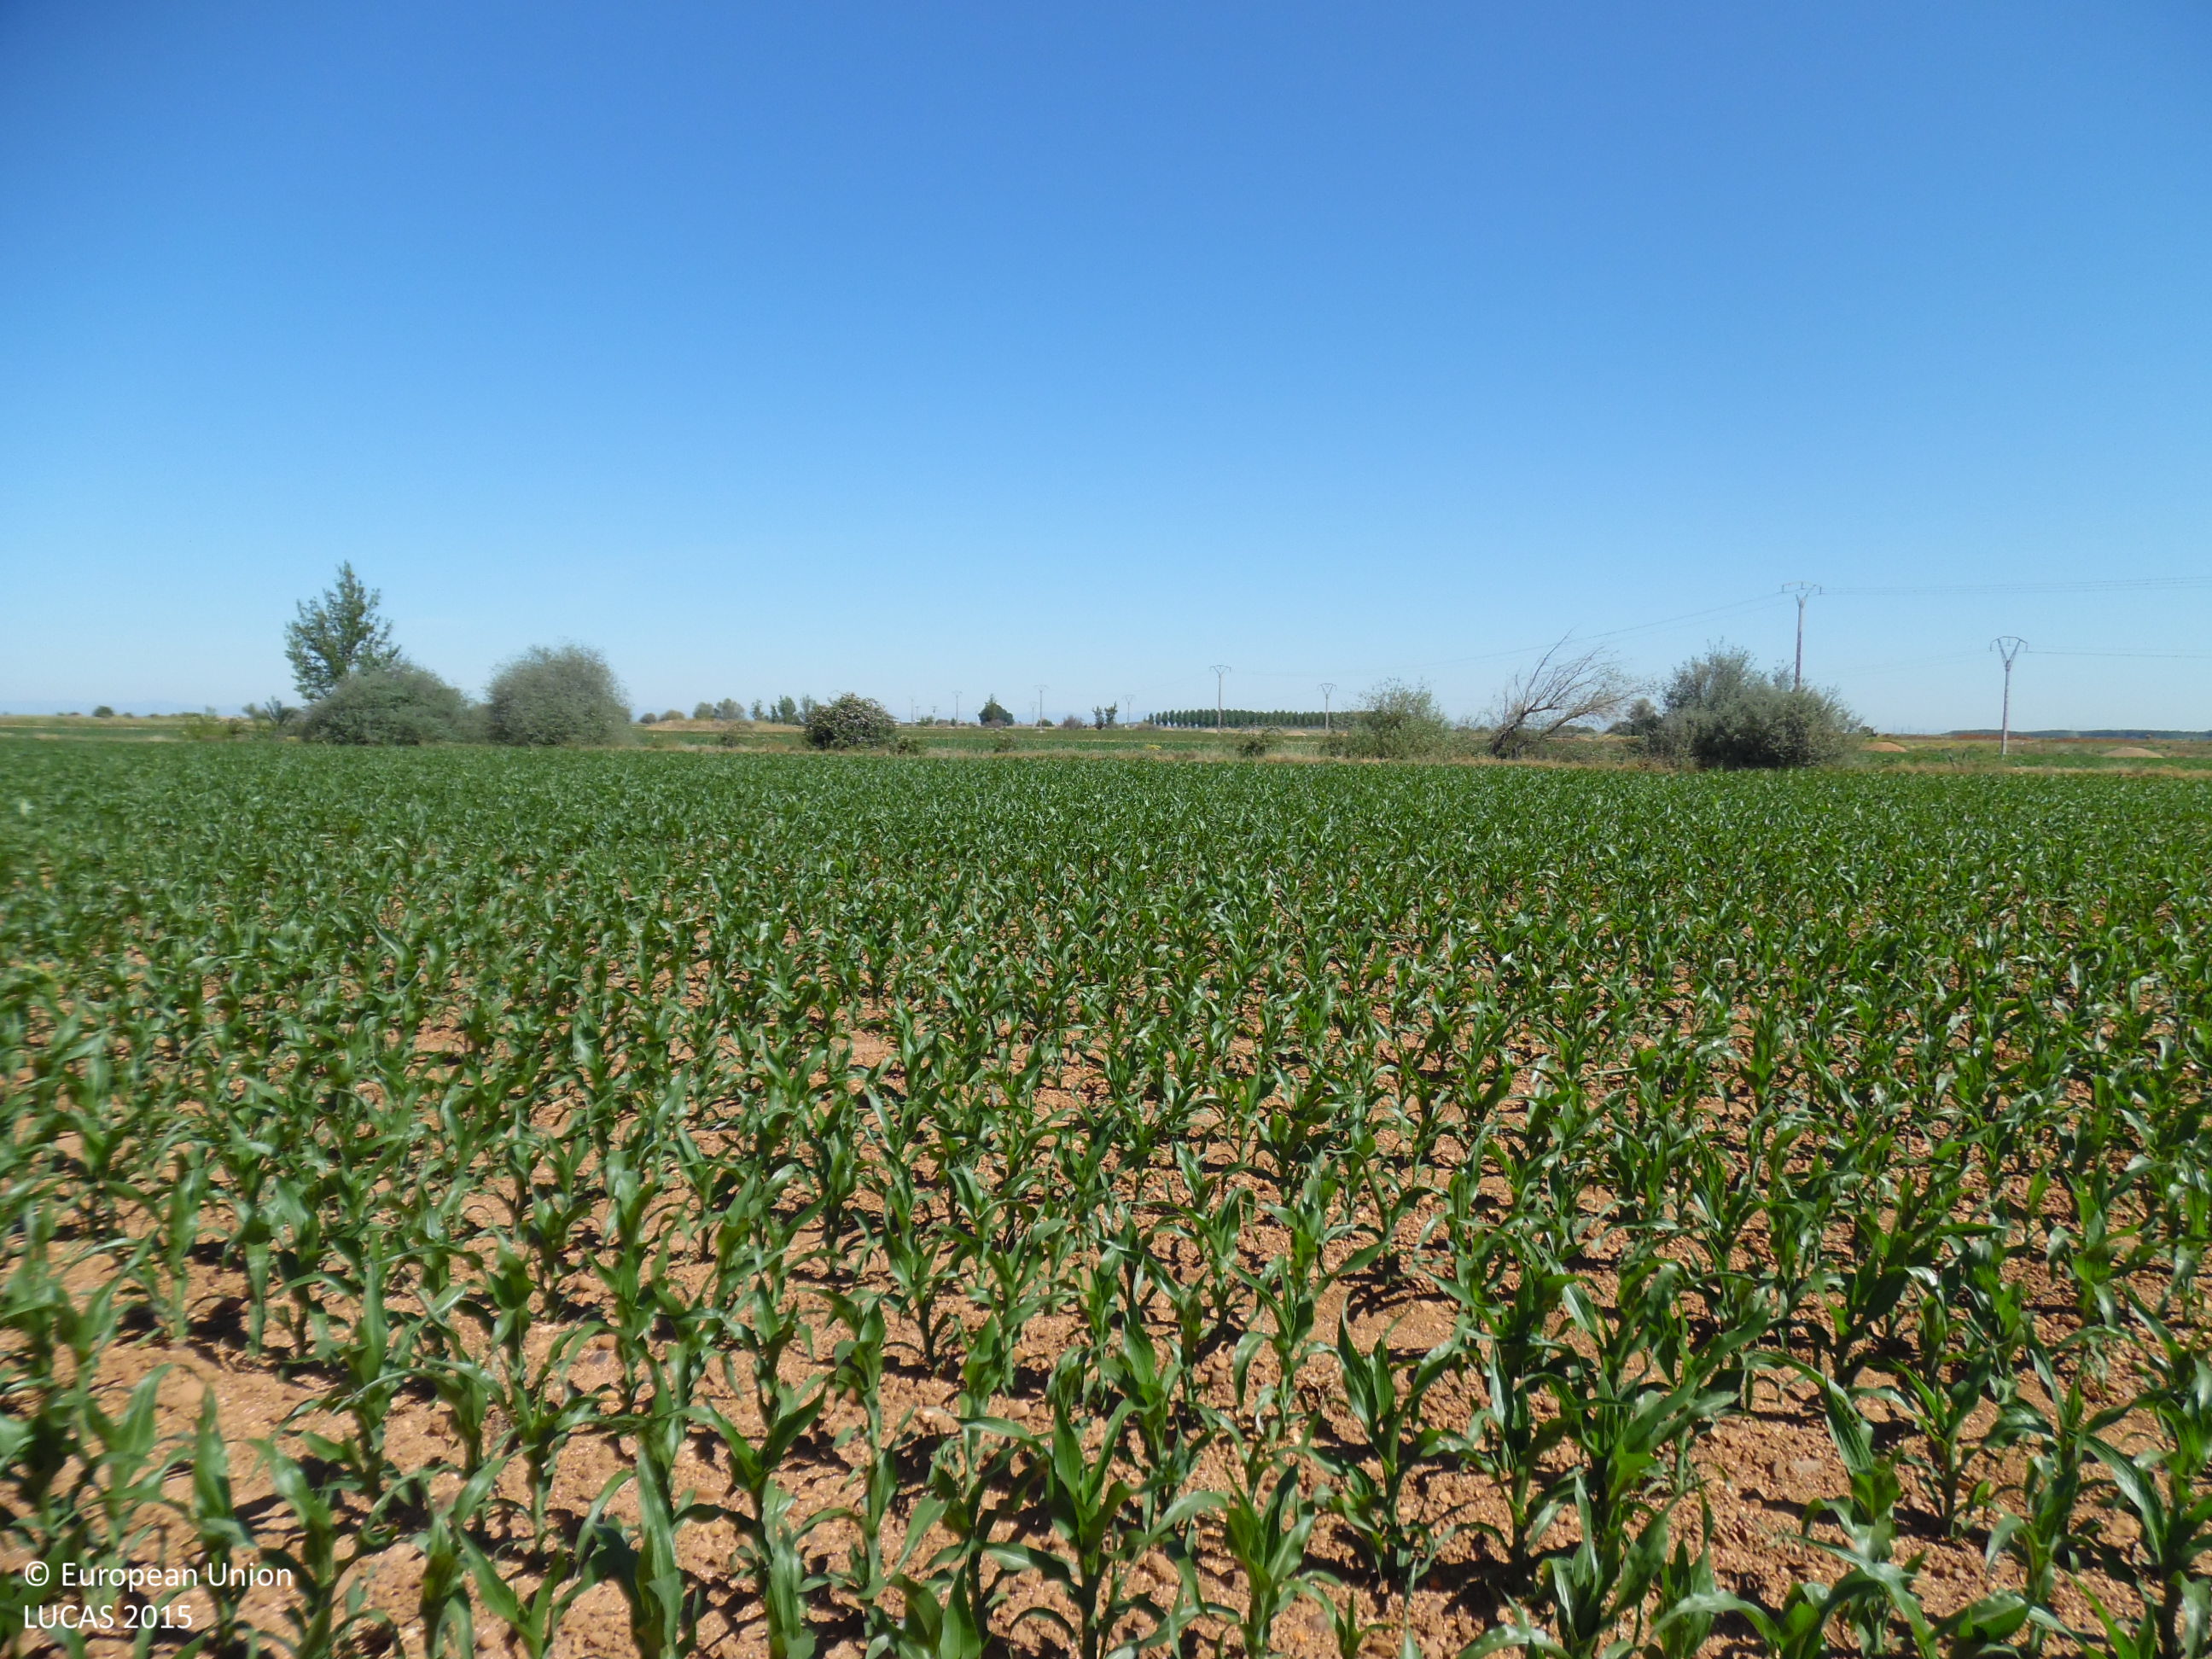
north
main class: Cropland
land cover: Maize
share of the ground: 50 - 75 %
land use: Agriculture (excluding fallow land and kitchen gardens)
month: June
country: ES
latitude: 42.2694
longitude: -5.6746
